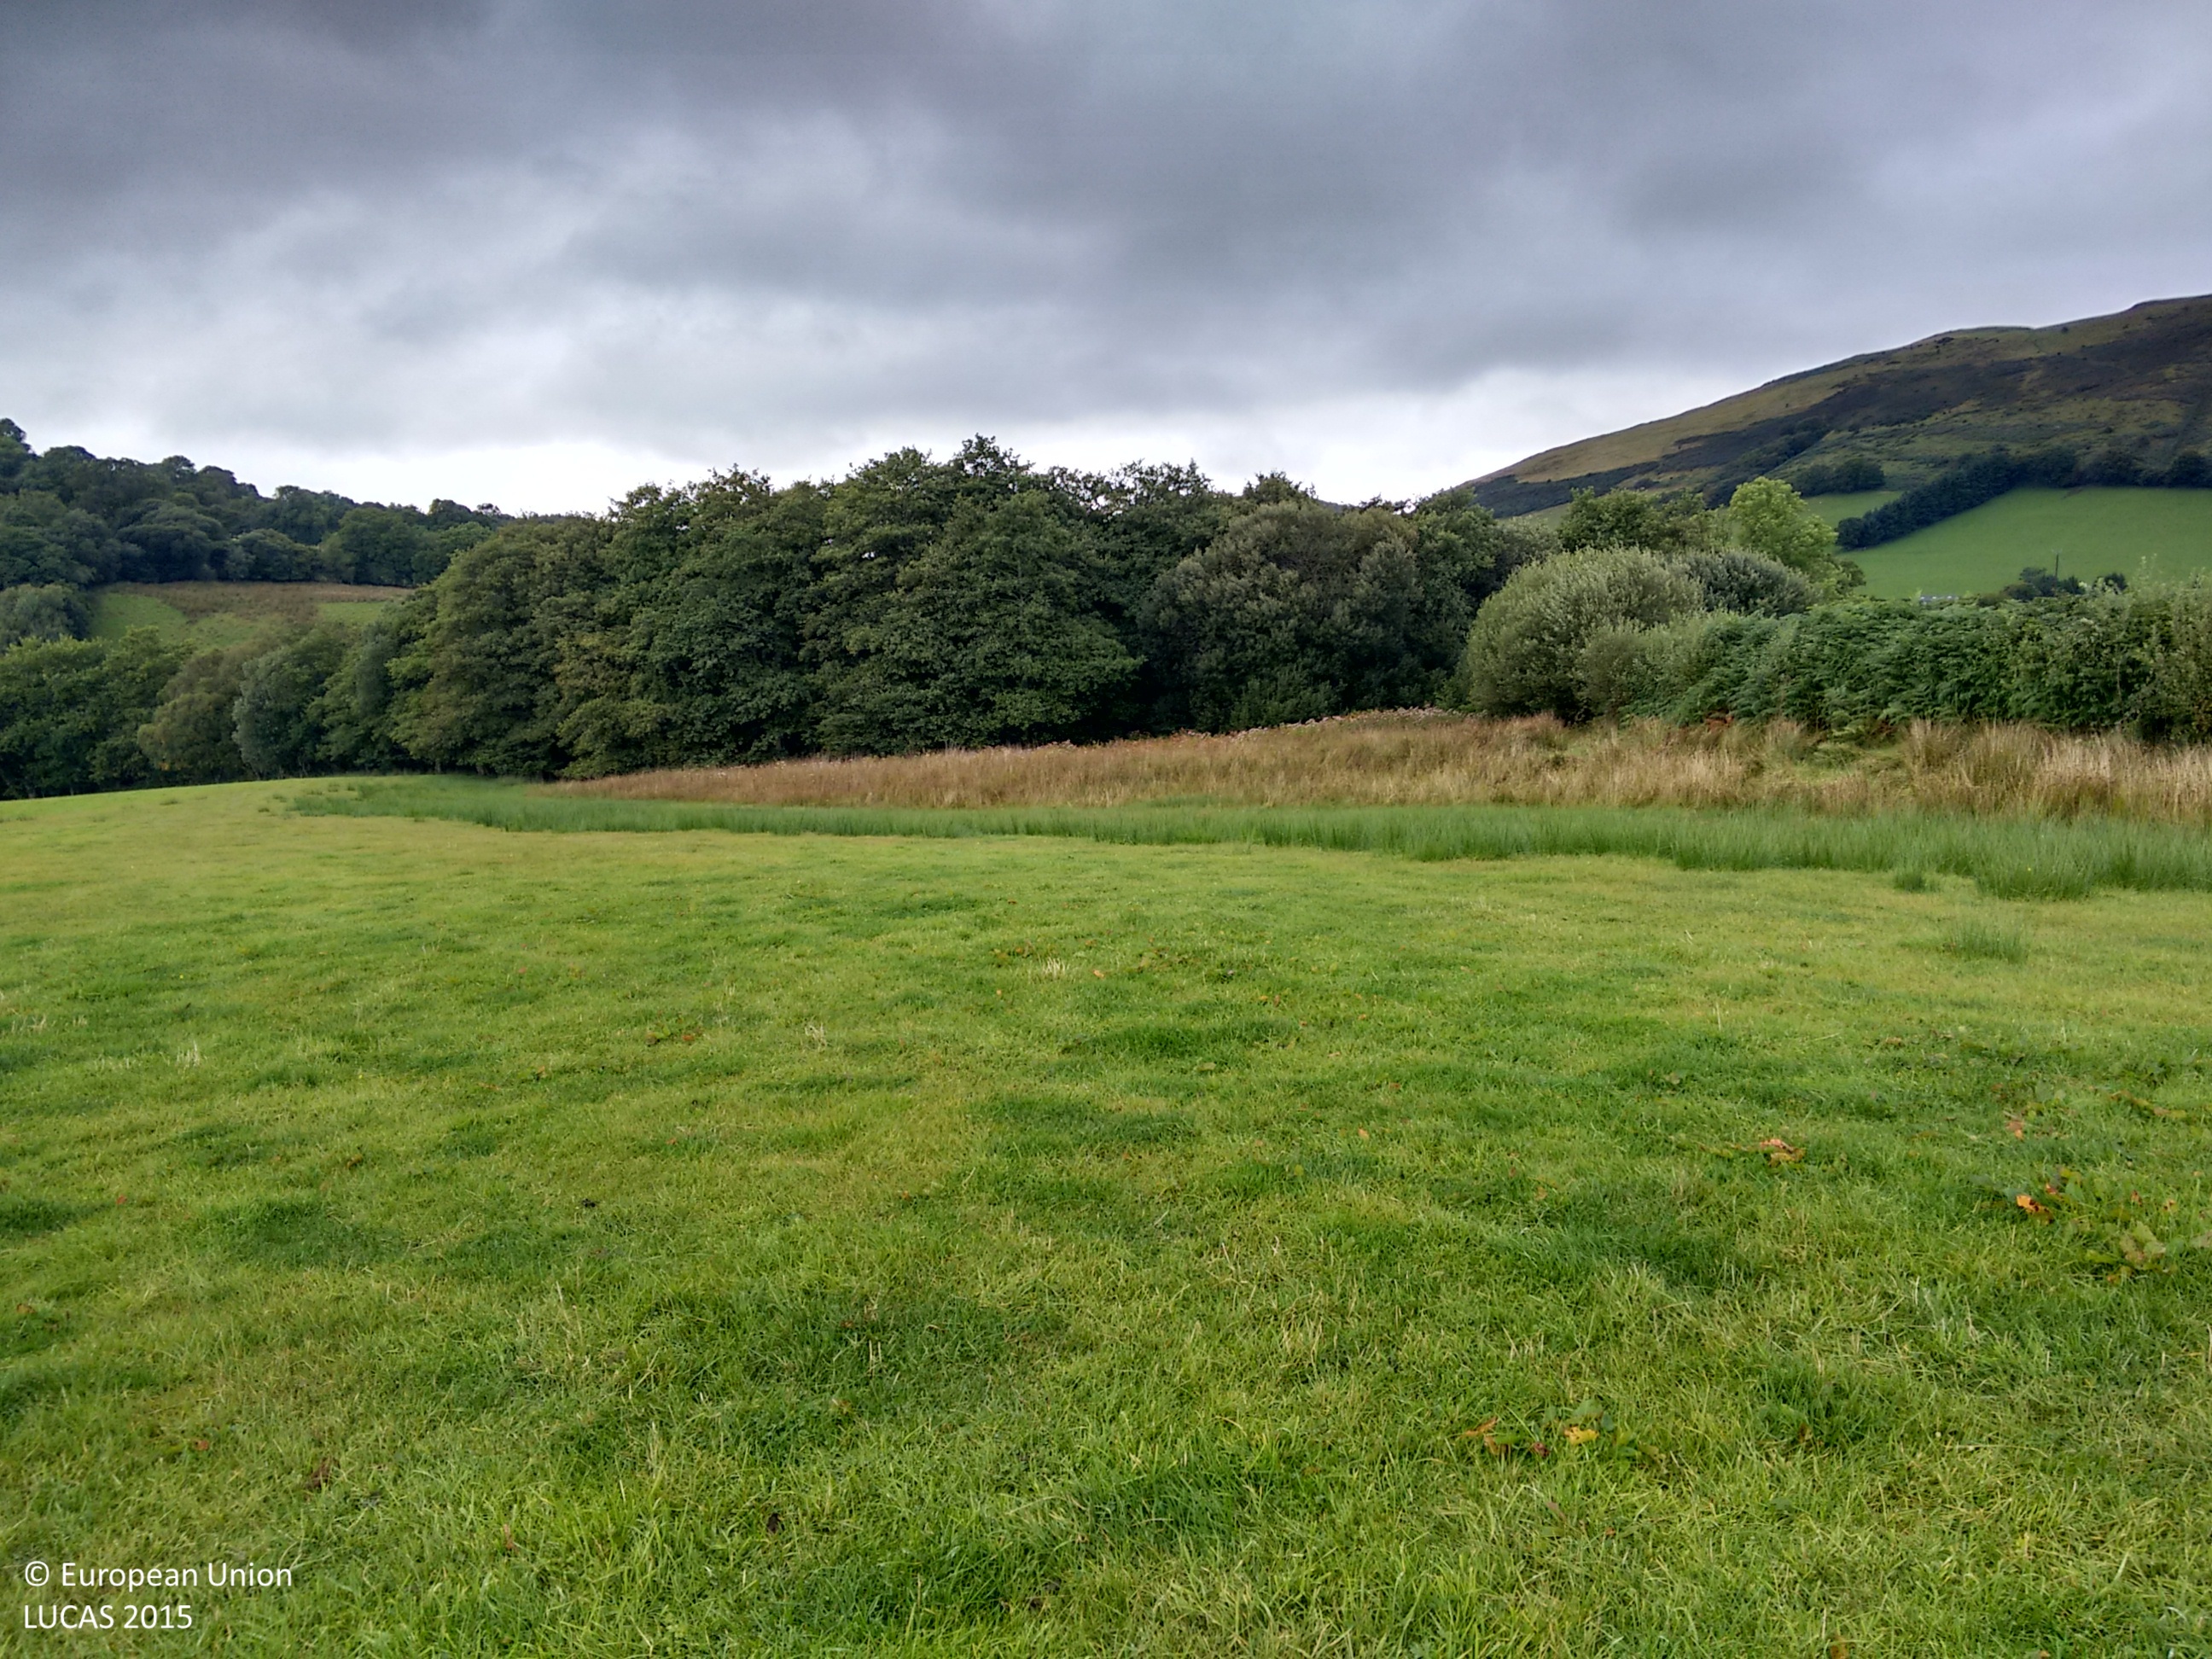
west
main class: Grassland
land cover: Grassland without tree/shrub cover
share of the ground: > 75 %
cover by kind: herbaceous plants 100 %
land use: Agriculture (excluding fallow land and kitchen gardens)
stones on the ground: < 10 %
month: September
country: GB
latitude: 52.0363
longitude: -3.8380
